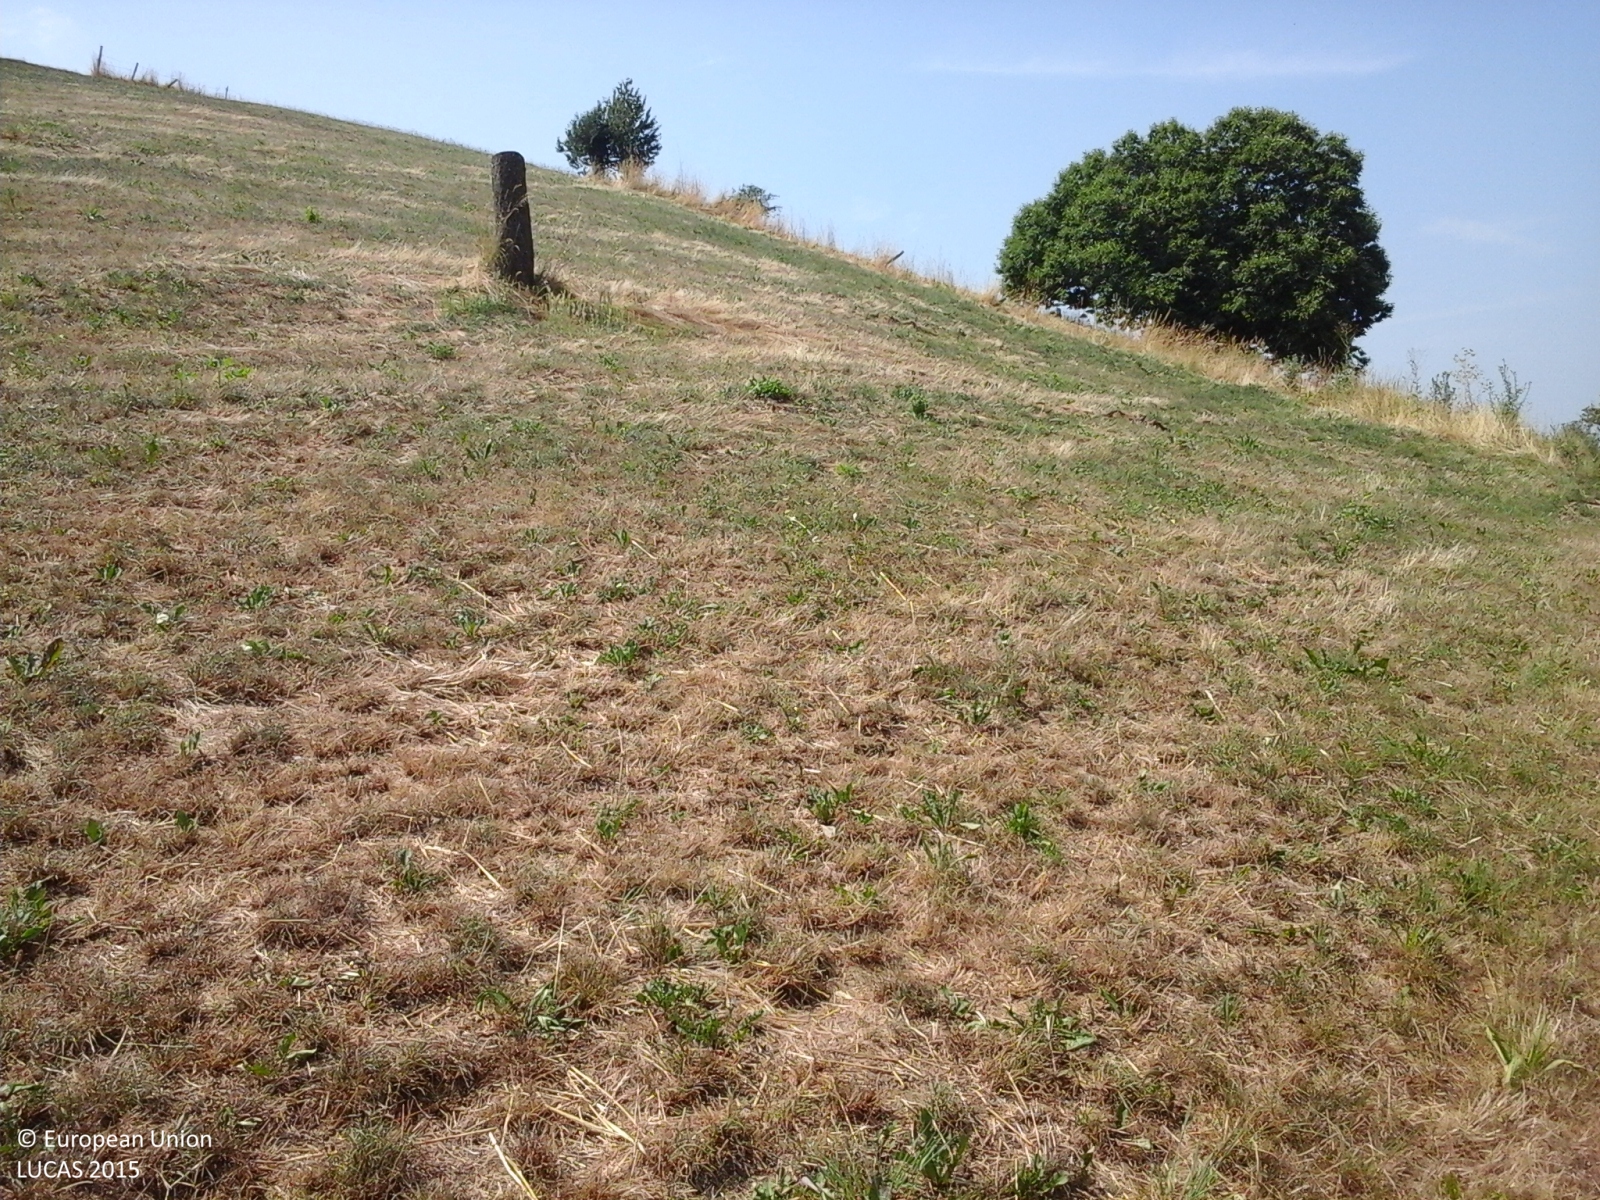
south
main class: Grassland
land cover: Grassland without tree/shrub cover
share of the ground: > 75 %
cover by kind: herbaceous plants 100 %
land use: Agriculture (excluding fallow land and kitchen gardens)
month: July
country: IT
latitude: 45.5706
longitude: 11.1129
